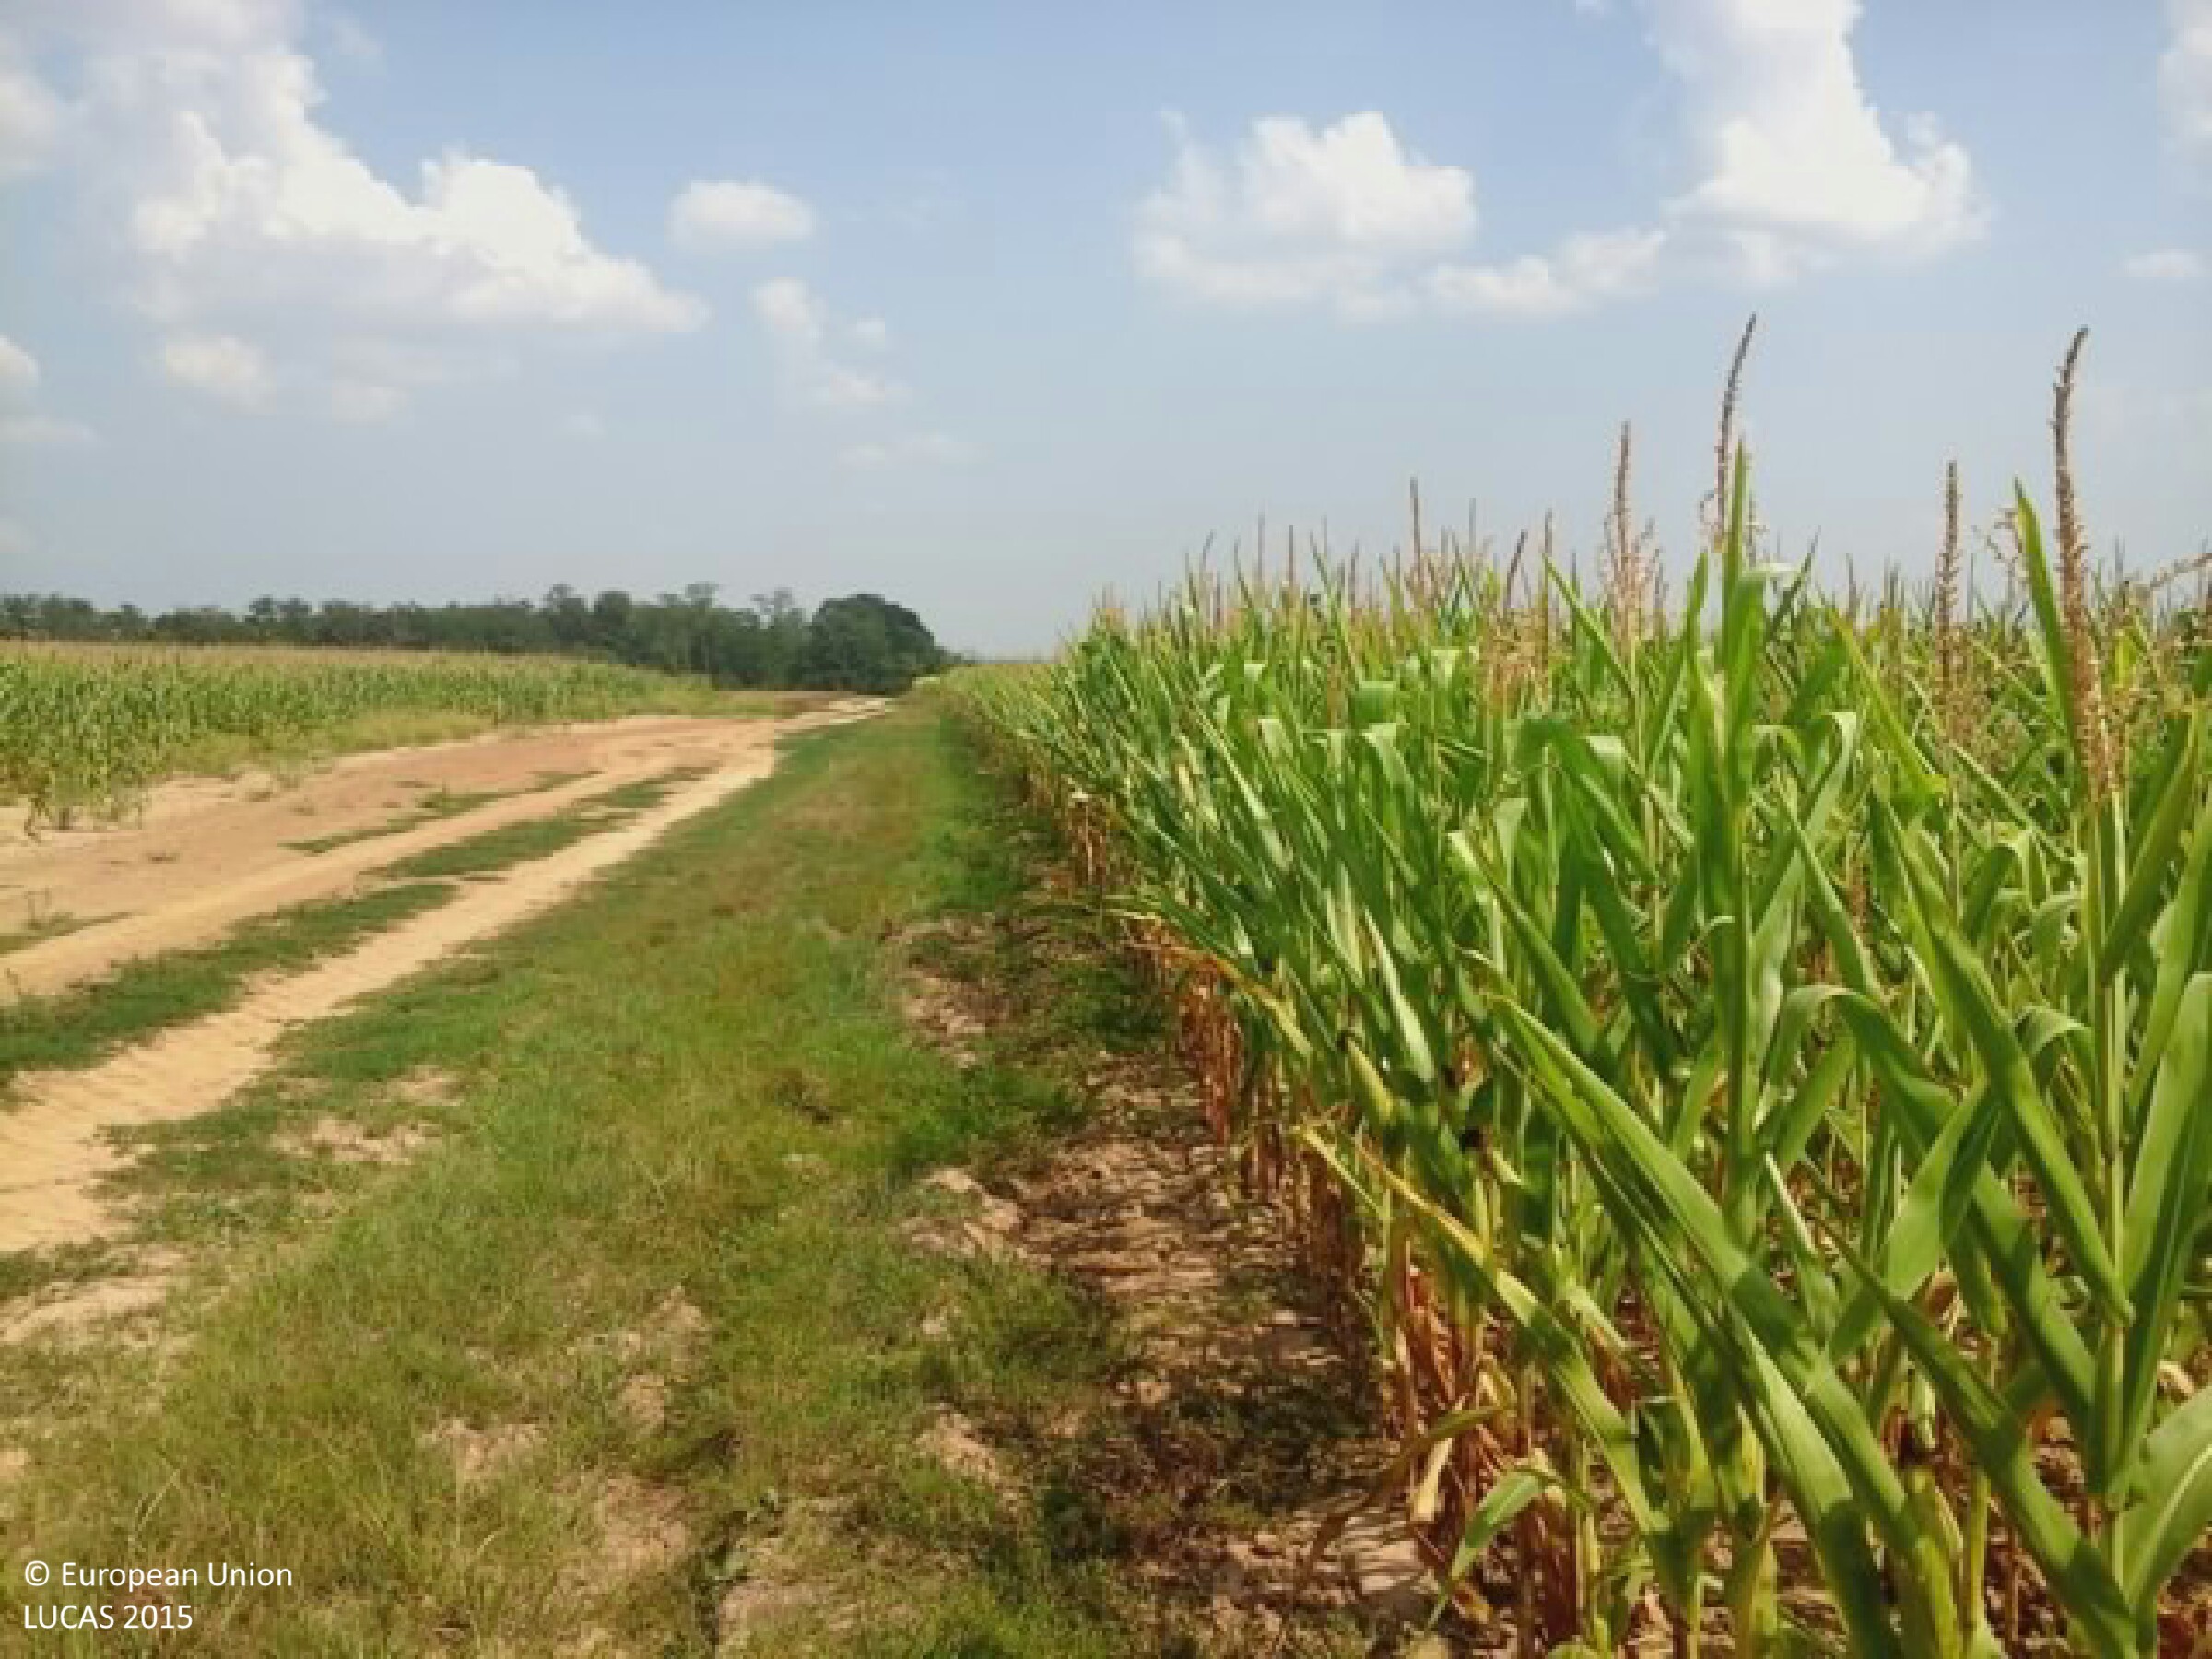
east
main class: Cropland
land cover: Maize
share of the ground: > 75 %
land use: Agriculture (excluding fallow land and kitchen gardens)
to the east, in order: Maize; Sunflower; Grass margins; Tracks; Grass margins; Sunflower
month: August
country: HU
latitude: 46.3571
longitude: 18.2610
